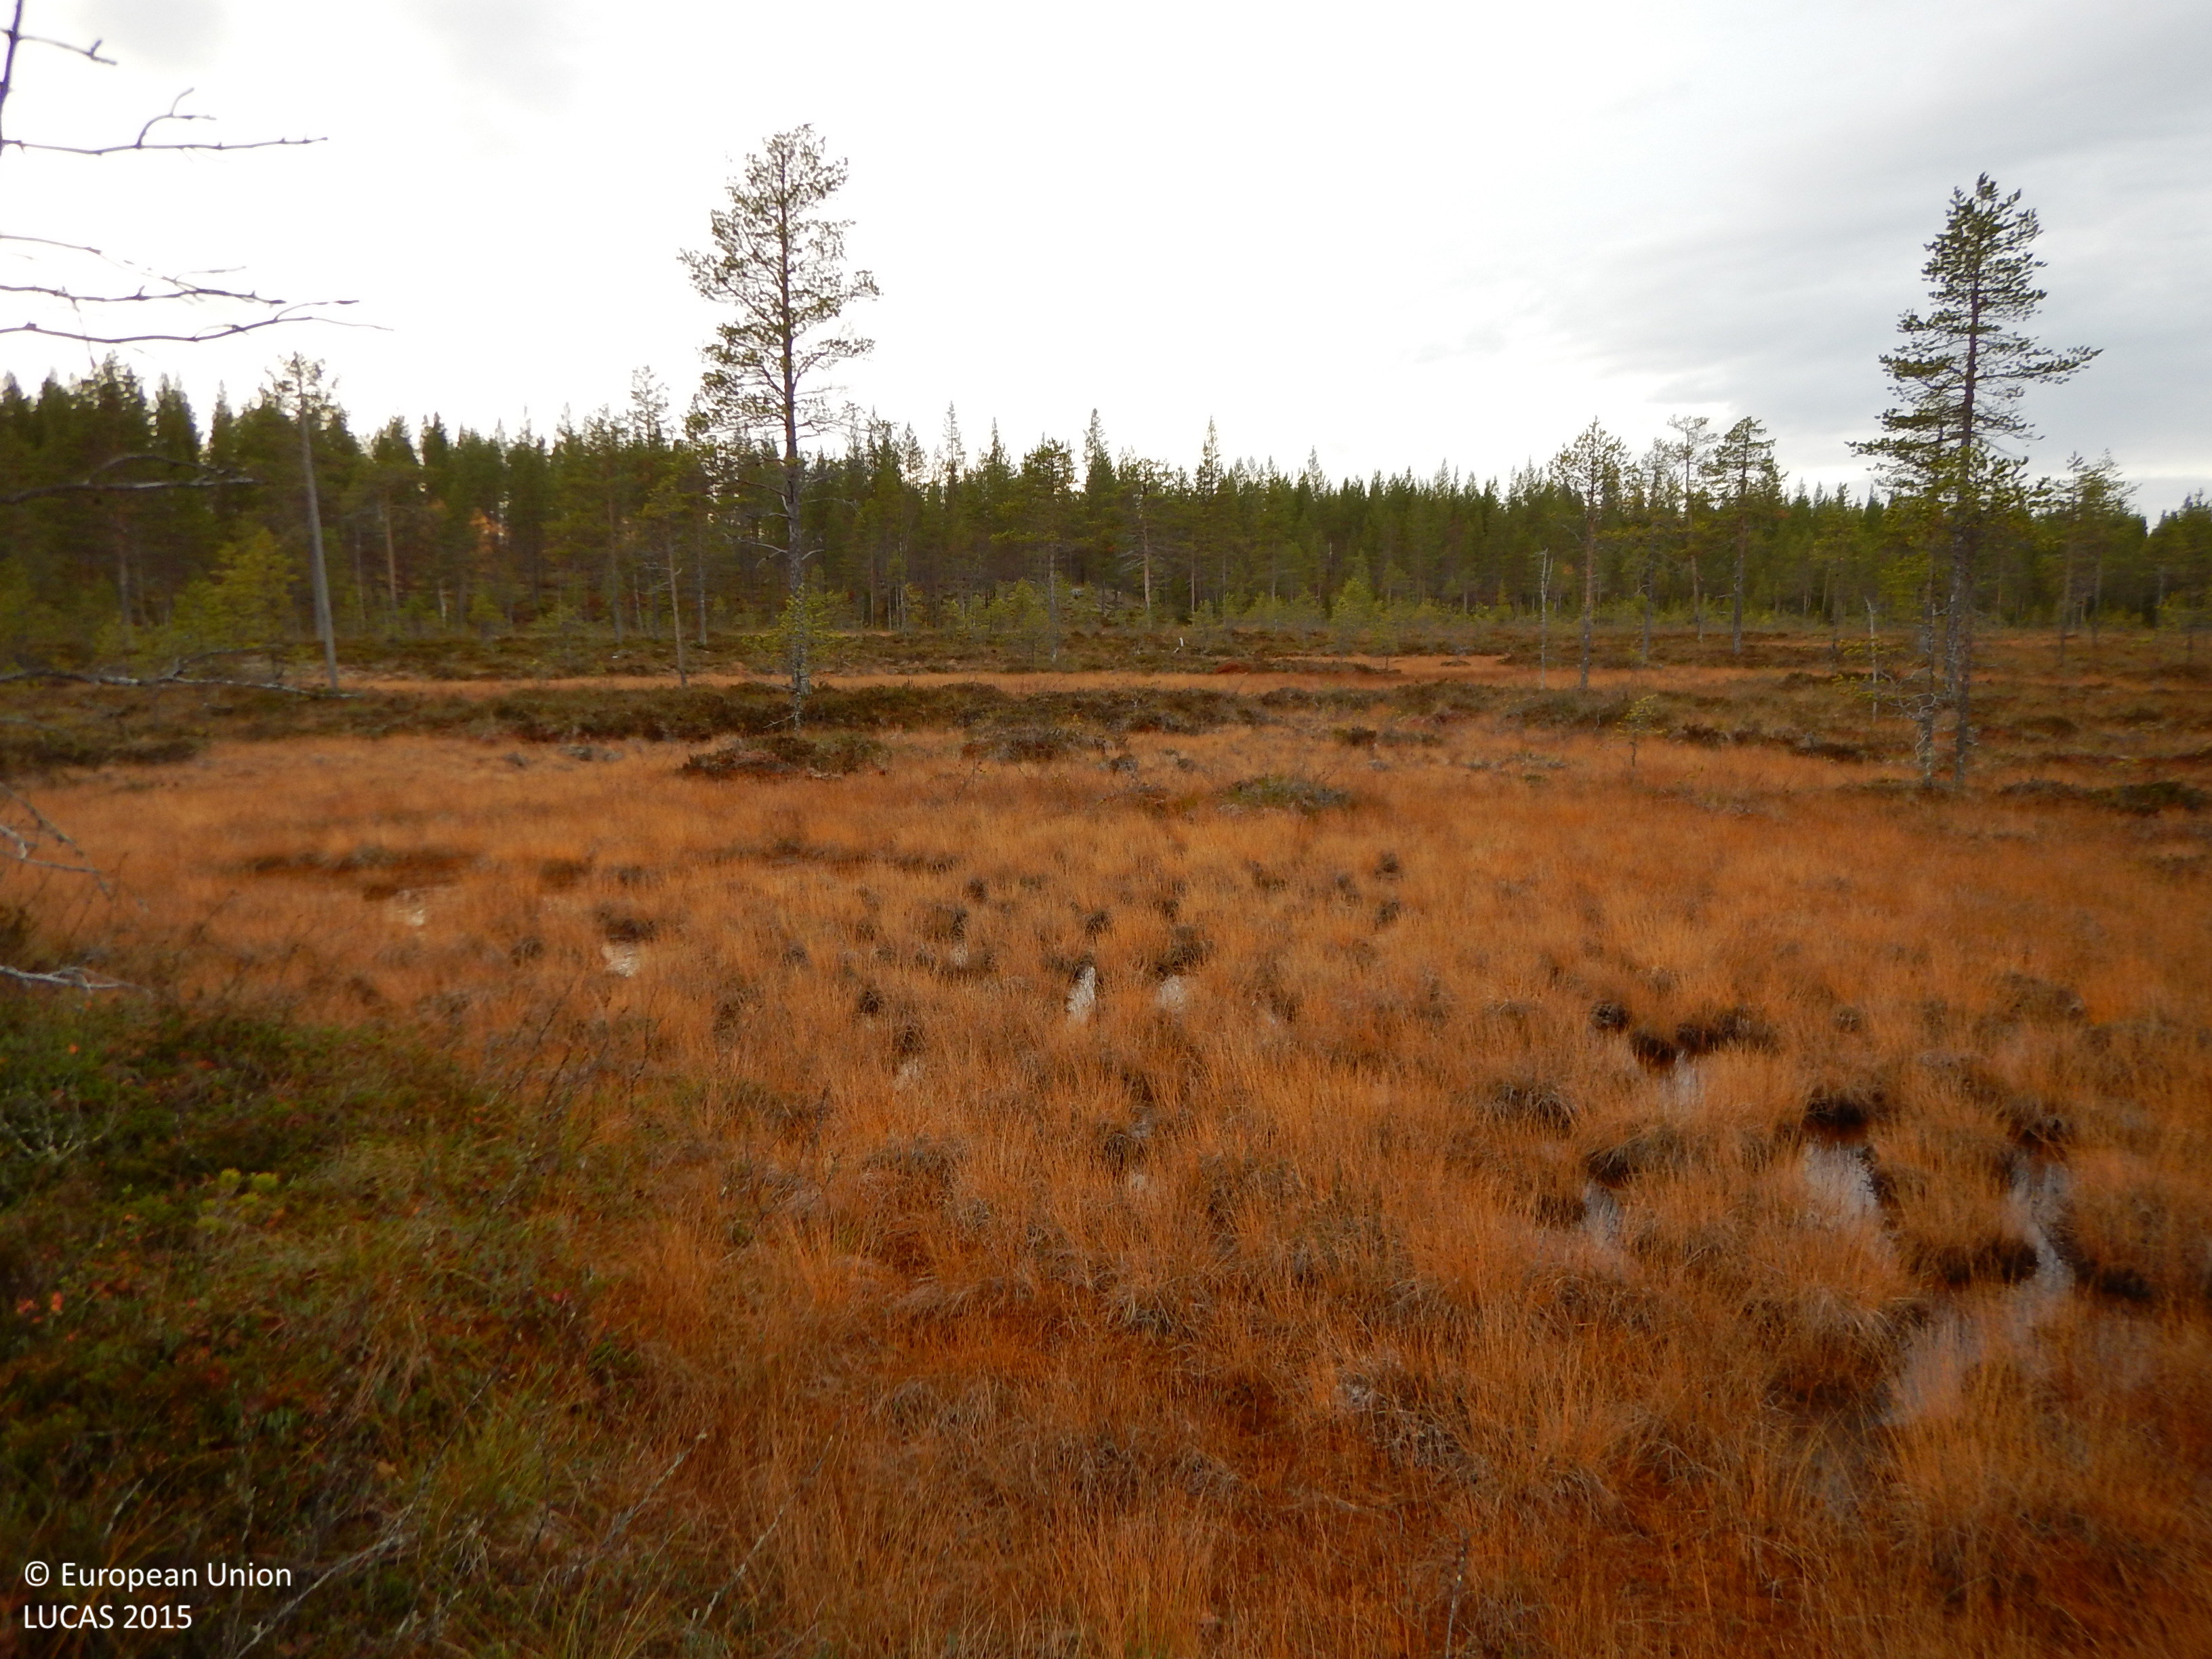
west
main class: Woodland
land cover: Pine dominated coniferous woodland
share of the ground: 10 - 25 %
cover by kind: herbaceous plants 30 %, lichens and mosses 30 %, coniferous forest trees 25 %, shrubs 15 %
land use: Semi-natural and natural areas not in use
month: September
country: SE
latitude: 65.0646
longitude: 20.3231
